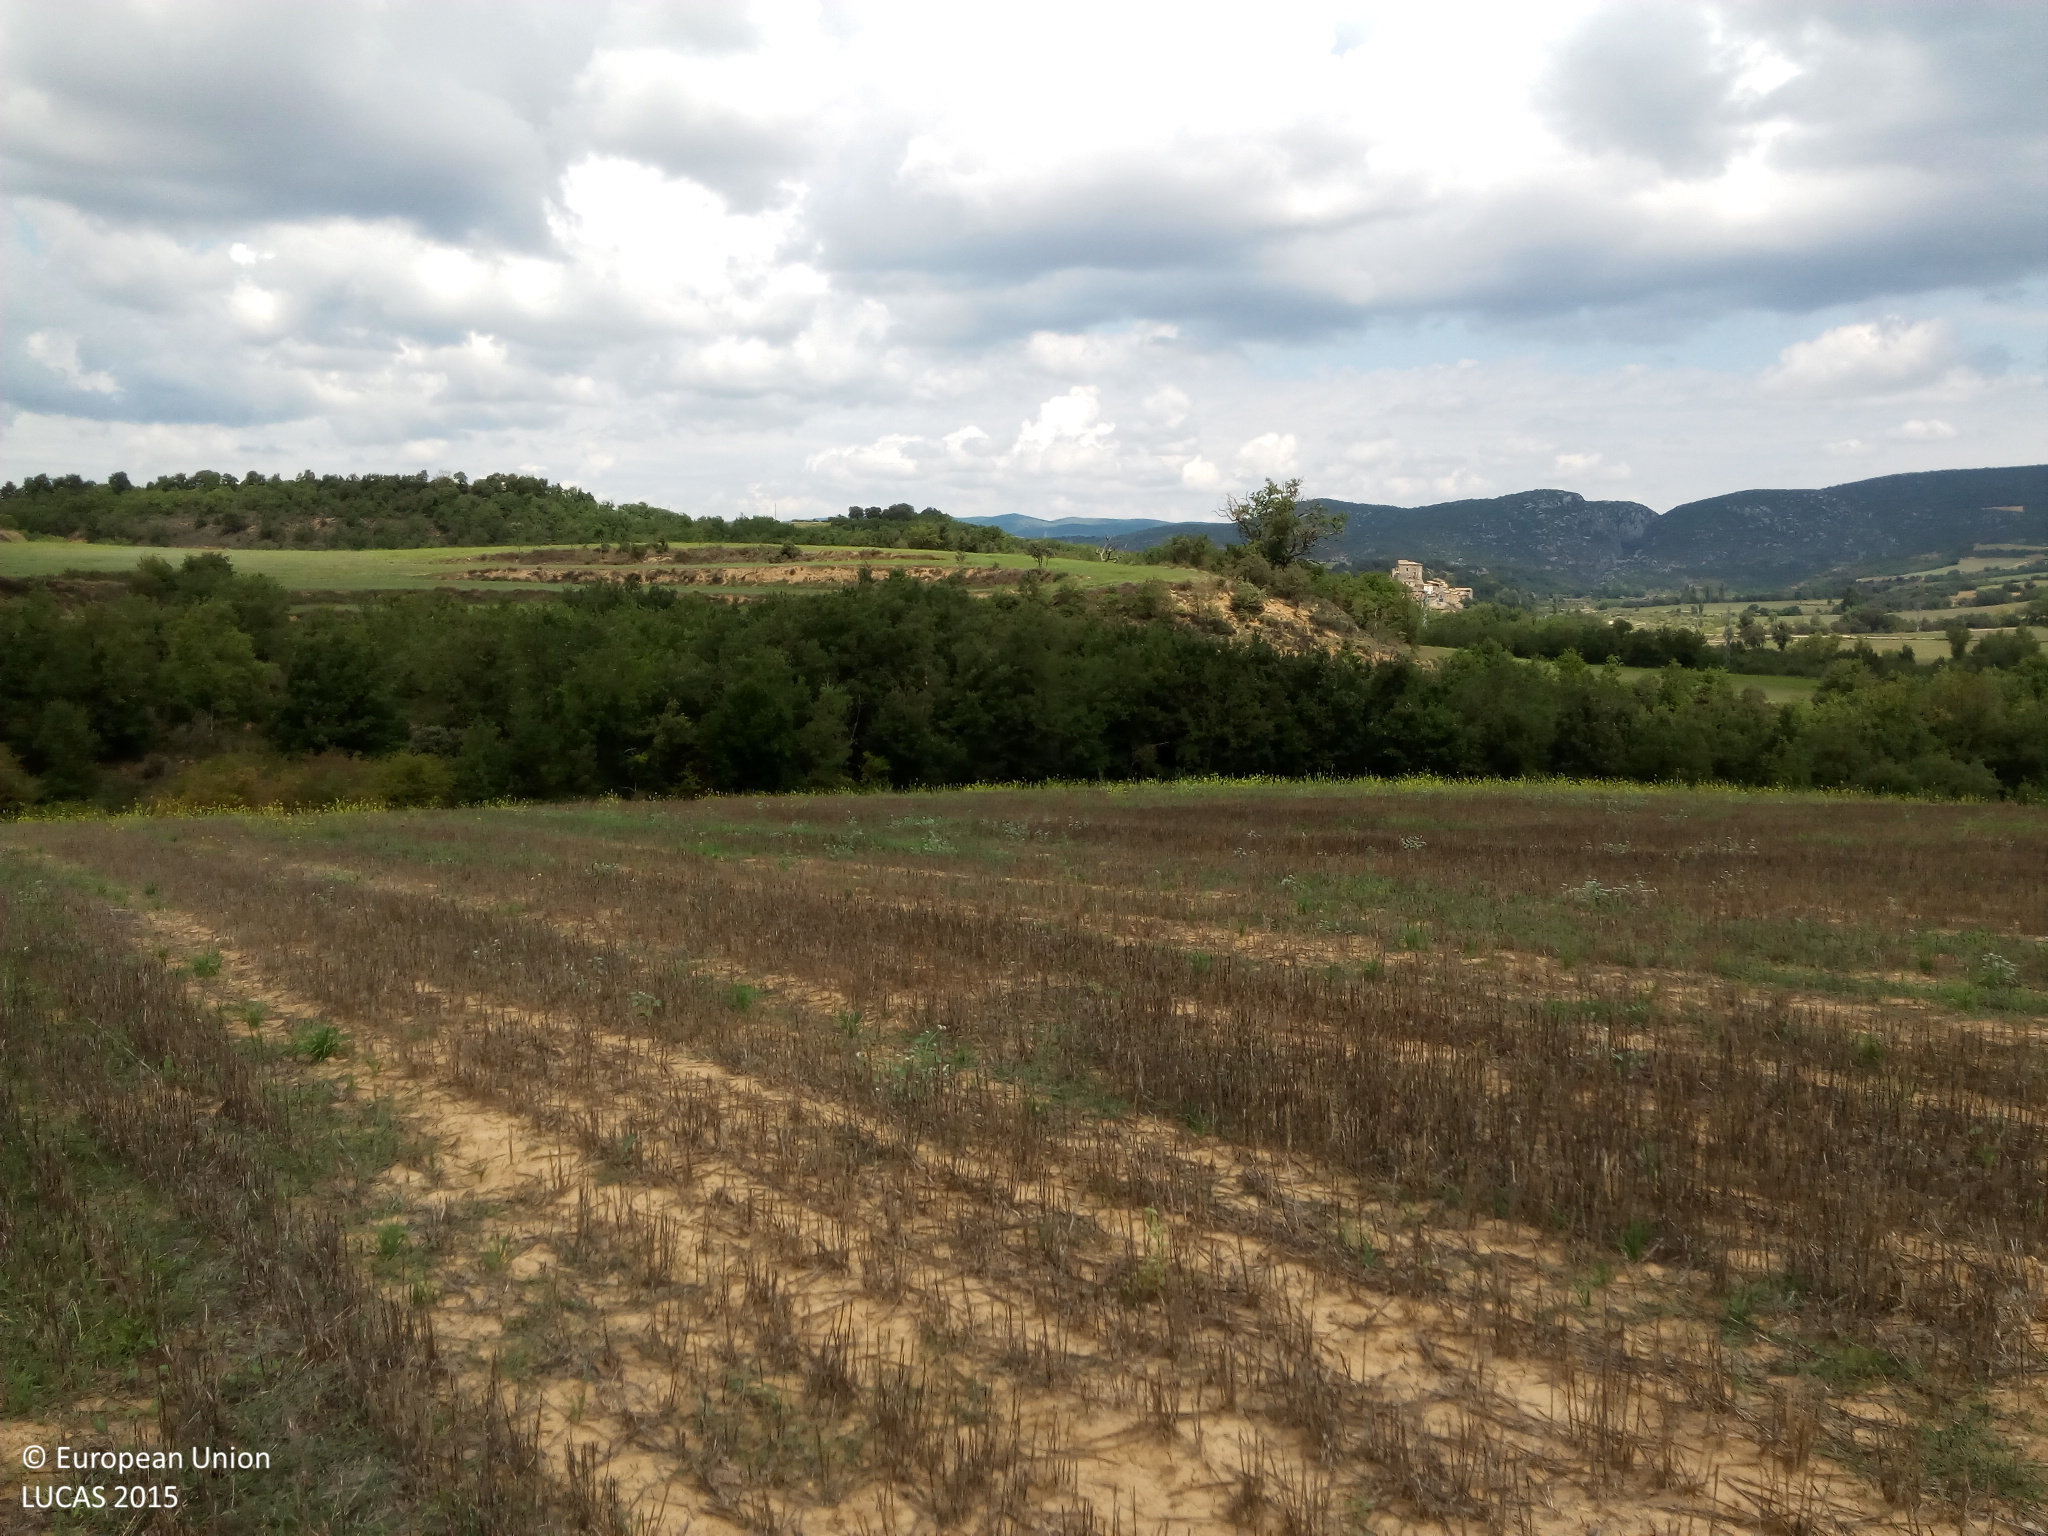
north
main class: Grassland
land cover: Spontaneously vegetated surfaces
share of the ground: > 75 %
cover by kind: unconsolidated bare surface 60 %, herbaceous plants 40 %
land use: Fallow land
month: August
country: ES
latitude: 42.0655
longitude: 0.5453
